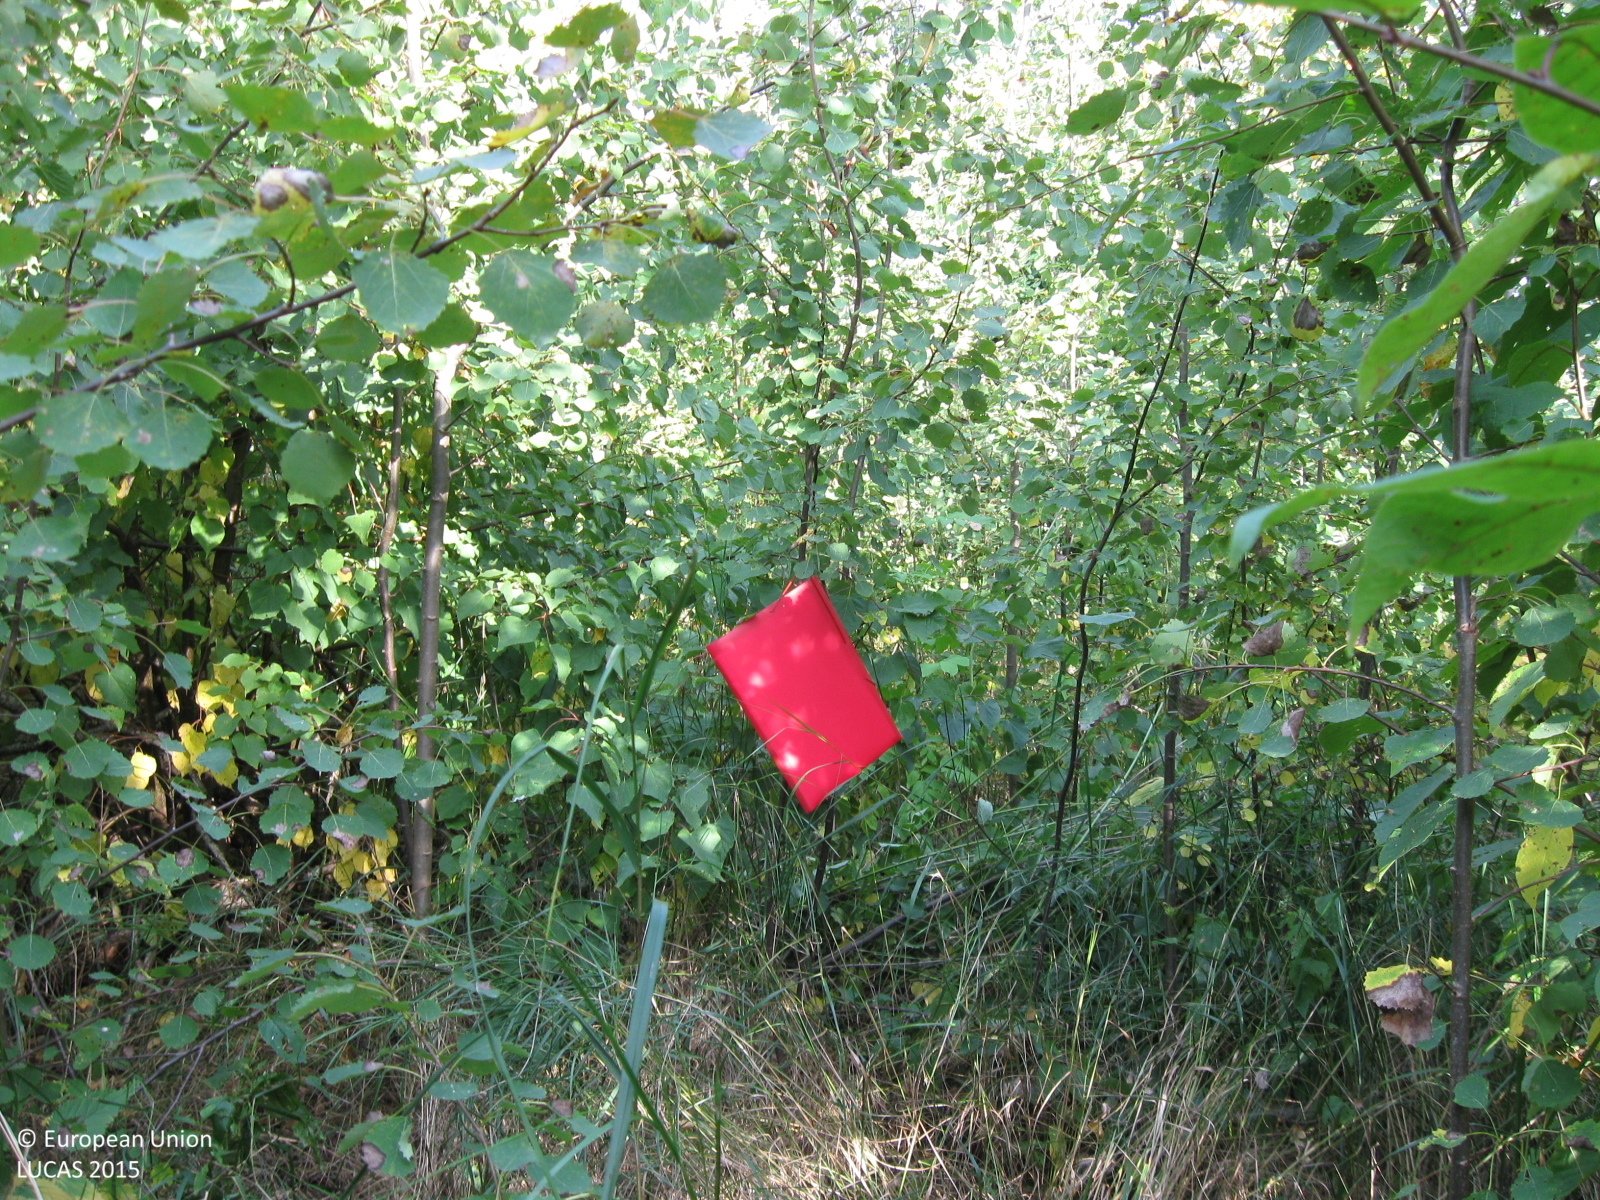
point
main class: Woodland
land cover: Broadleaved woodland
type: non-riverine alder, birch or aspen forest
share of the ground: > 75 %
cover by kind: broadleaved forest trees 80 %, herbaceous plants 20 %
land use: Forestry
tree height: < 5 m
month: August
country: LT
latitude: 55.5987
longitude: 22.9715
